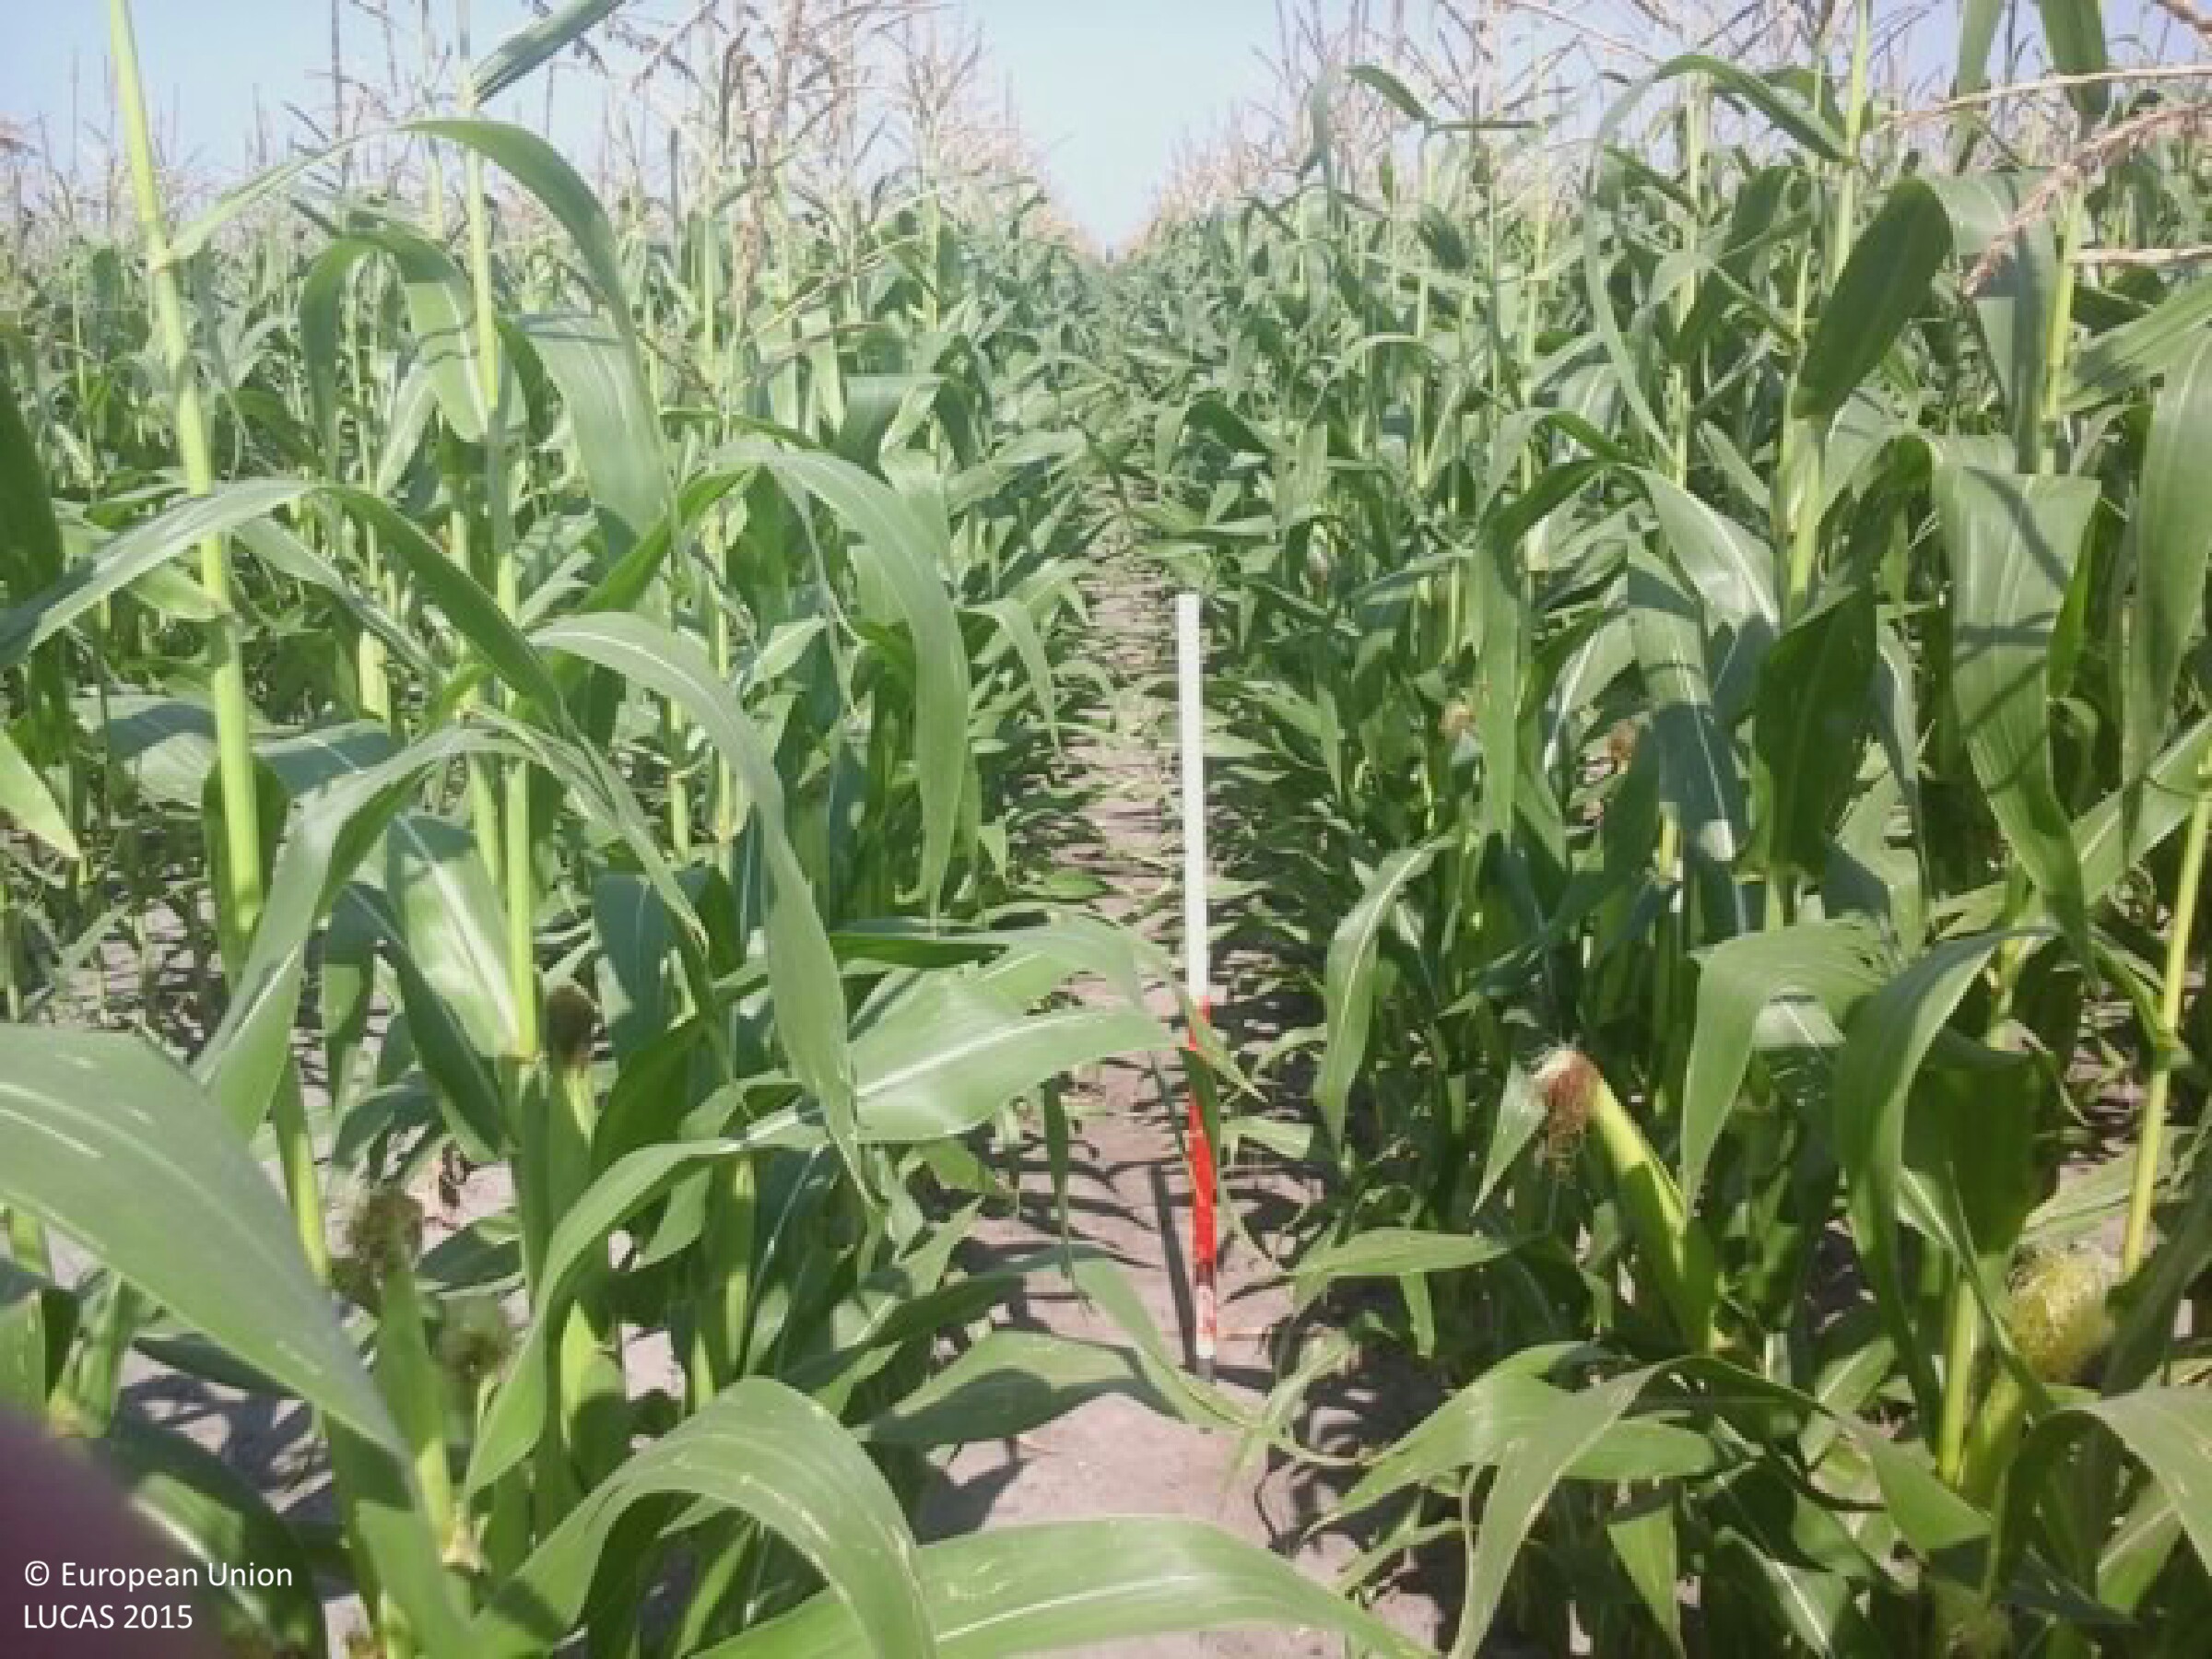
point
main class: Cropland
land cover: Maize
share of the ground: > 75 %
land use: Agriculture (excluding fallow land and kitchen gardens)
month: August
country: HU
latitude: 47.1290
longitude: 19.2326
